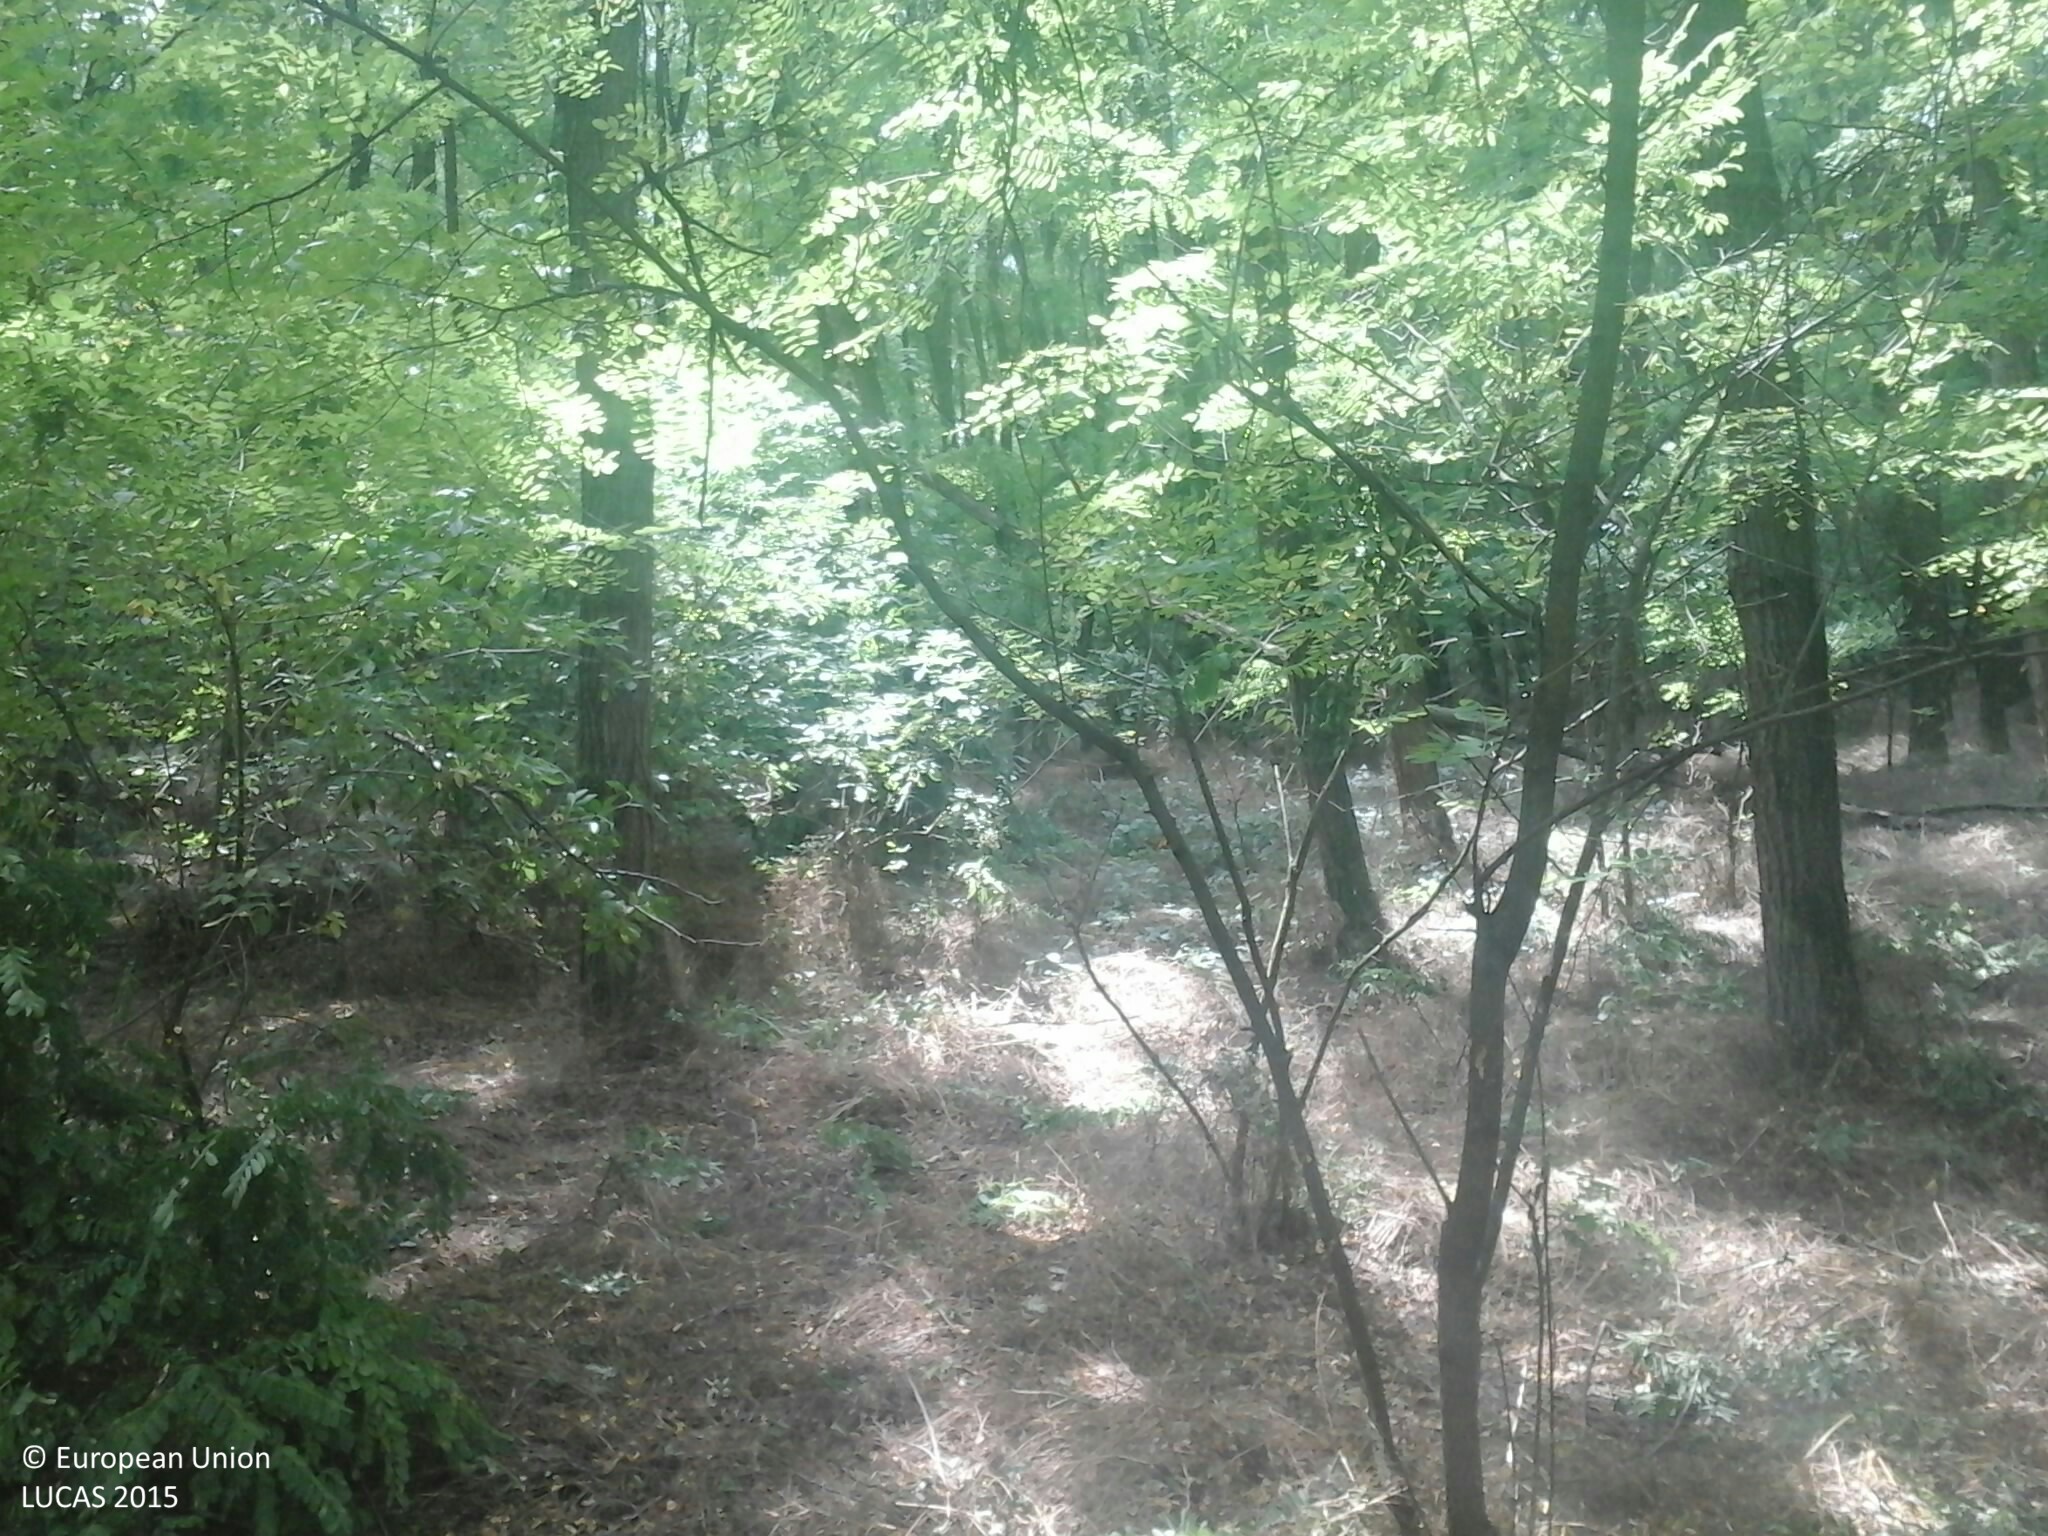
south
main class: Woodland
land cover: Broadleaved woodland
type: mesophytic deciduous forest
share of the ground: > 75 %
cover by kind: broadleaved forest trees 95 %, herbaceous plants 5 %
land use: Forestry
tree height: > 5 m
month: July
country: HU
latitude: 47.2114
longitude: 19.3272
